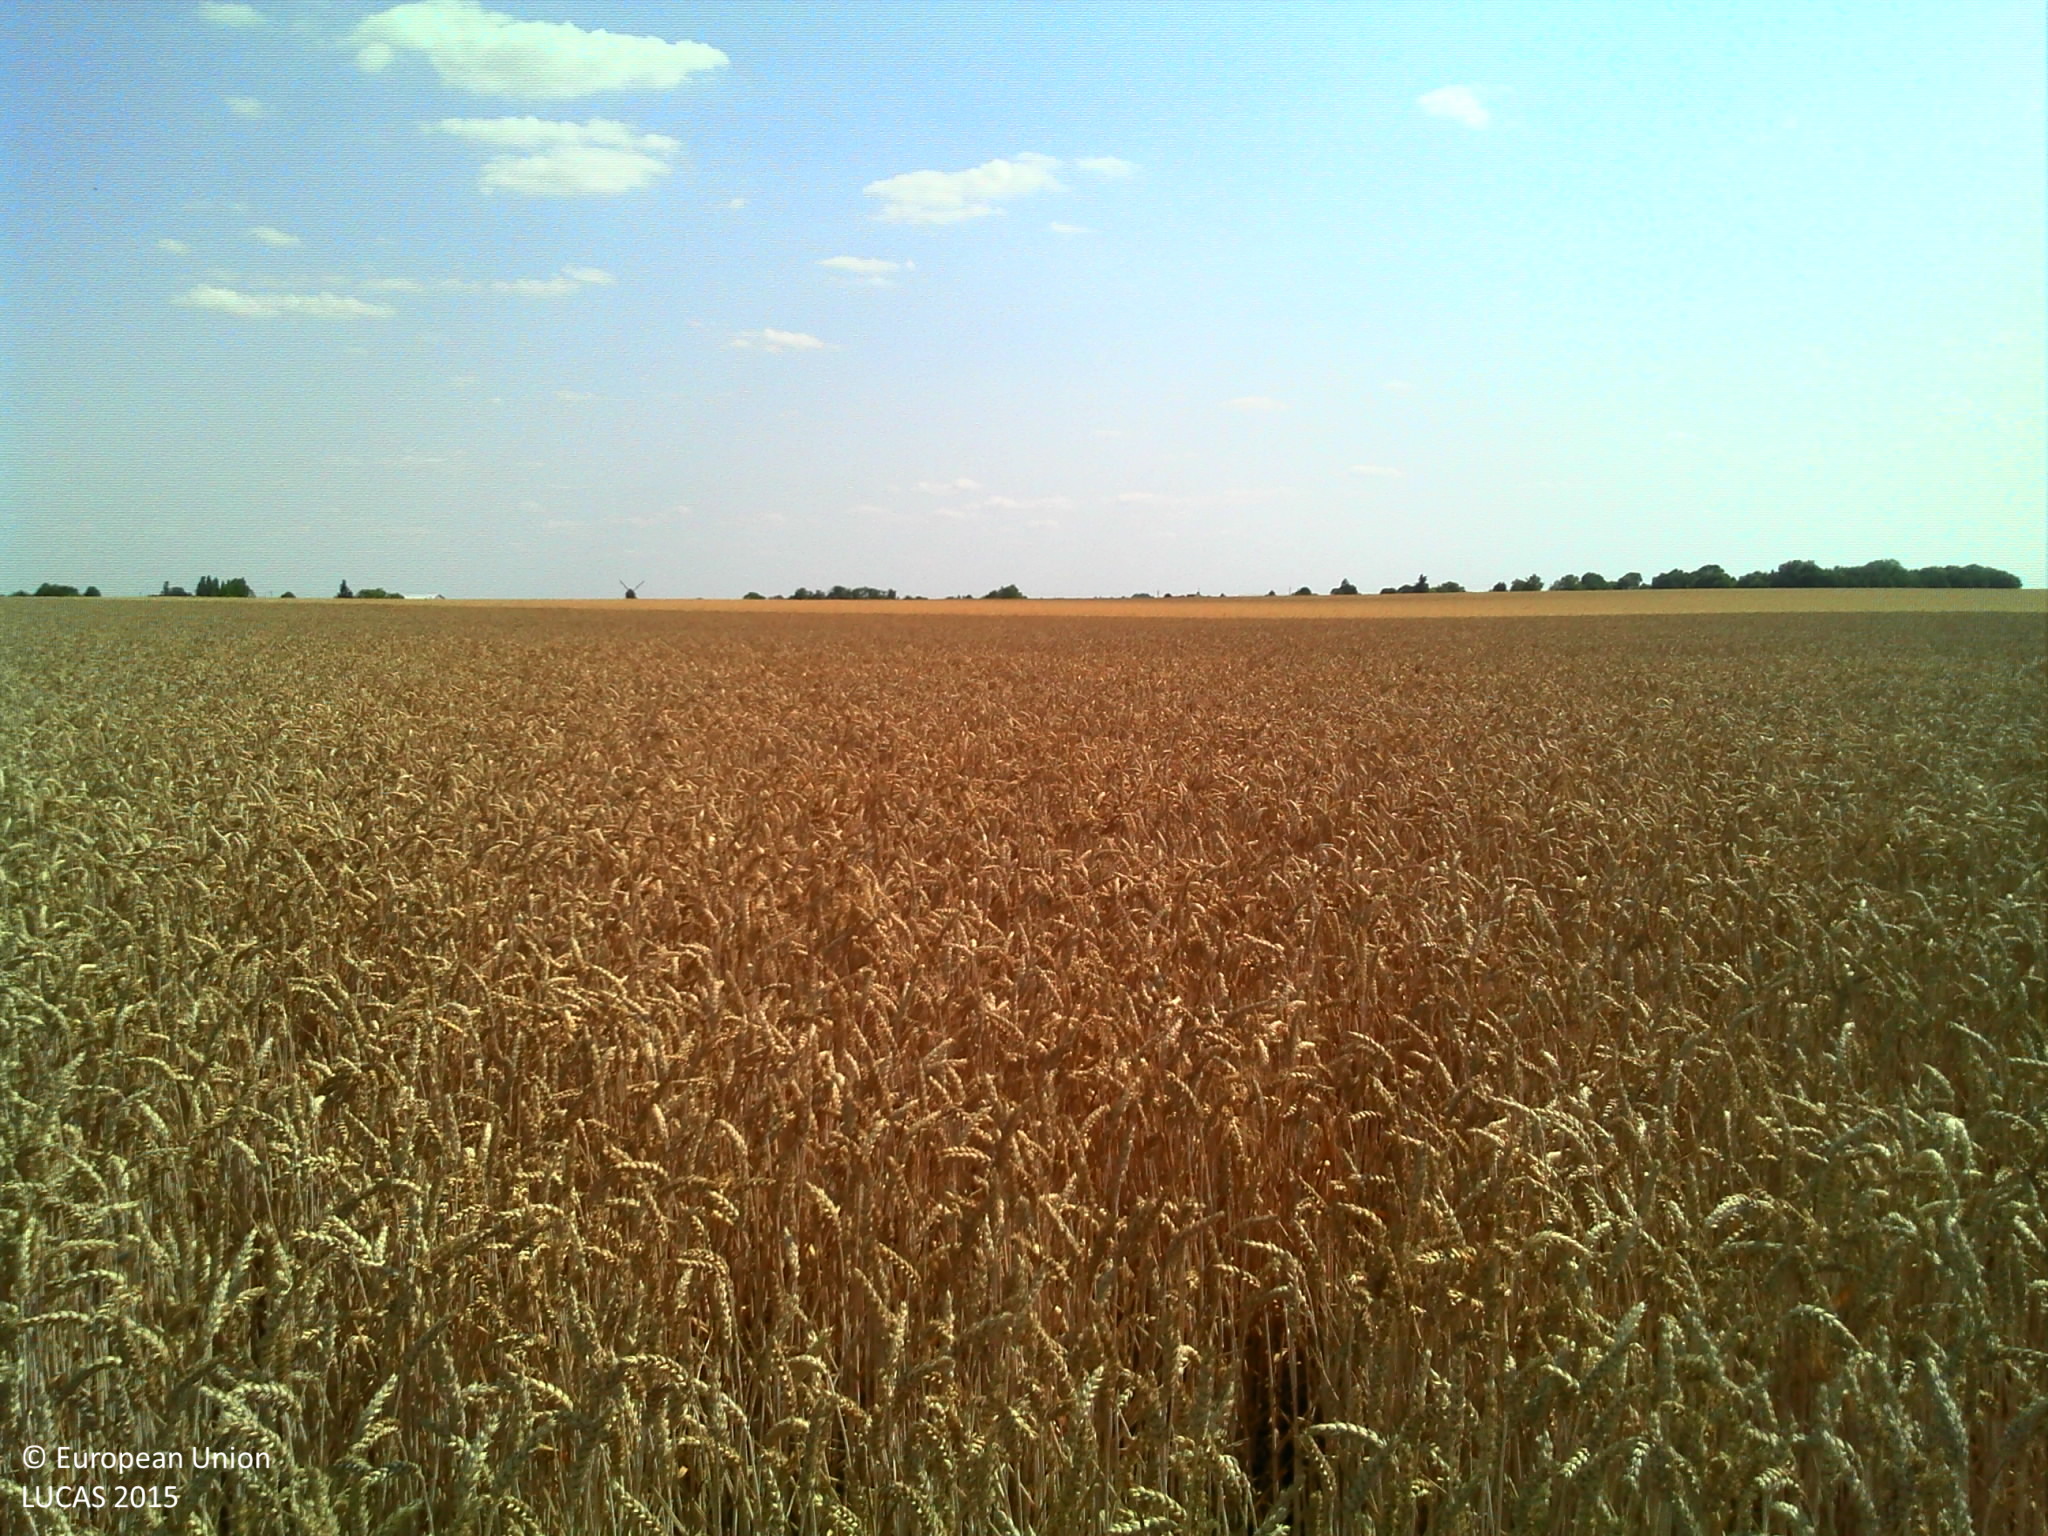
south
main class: Cropland
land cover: Common wheat
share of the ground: > 75 %
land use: Agriculture (excluding fallow land and kitchen gardens)
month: July
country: FR
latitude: 48.0451
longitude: 2.5727
